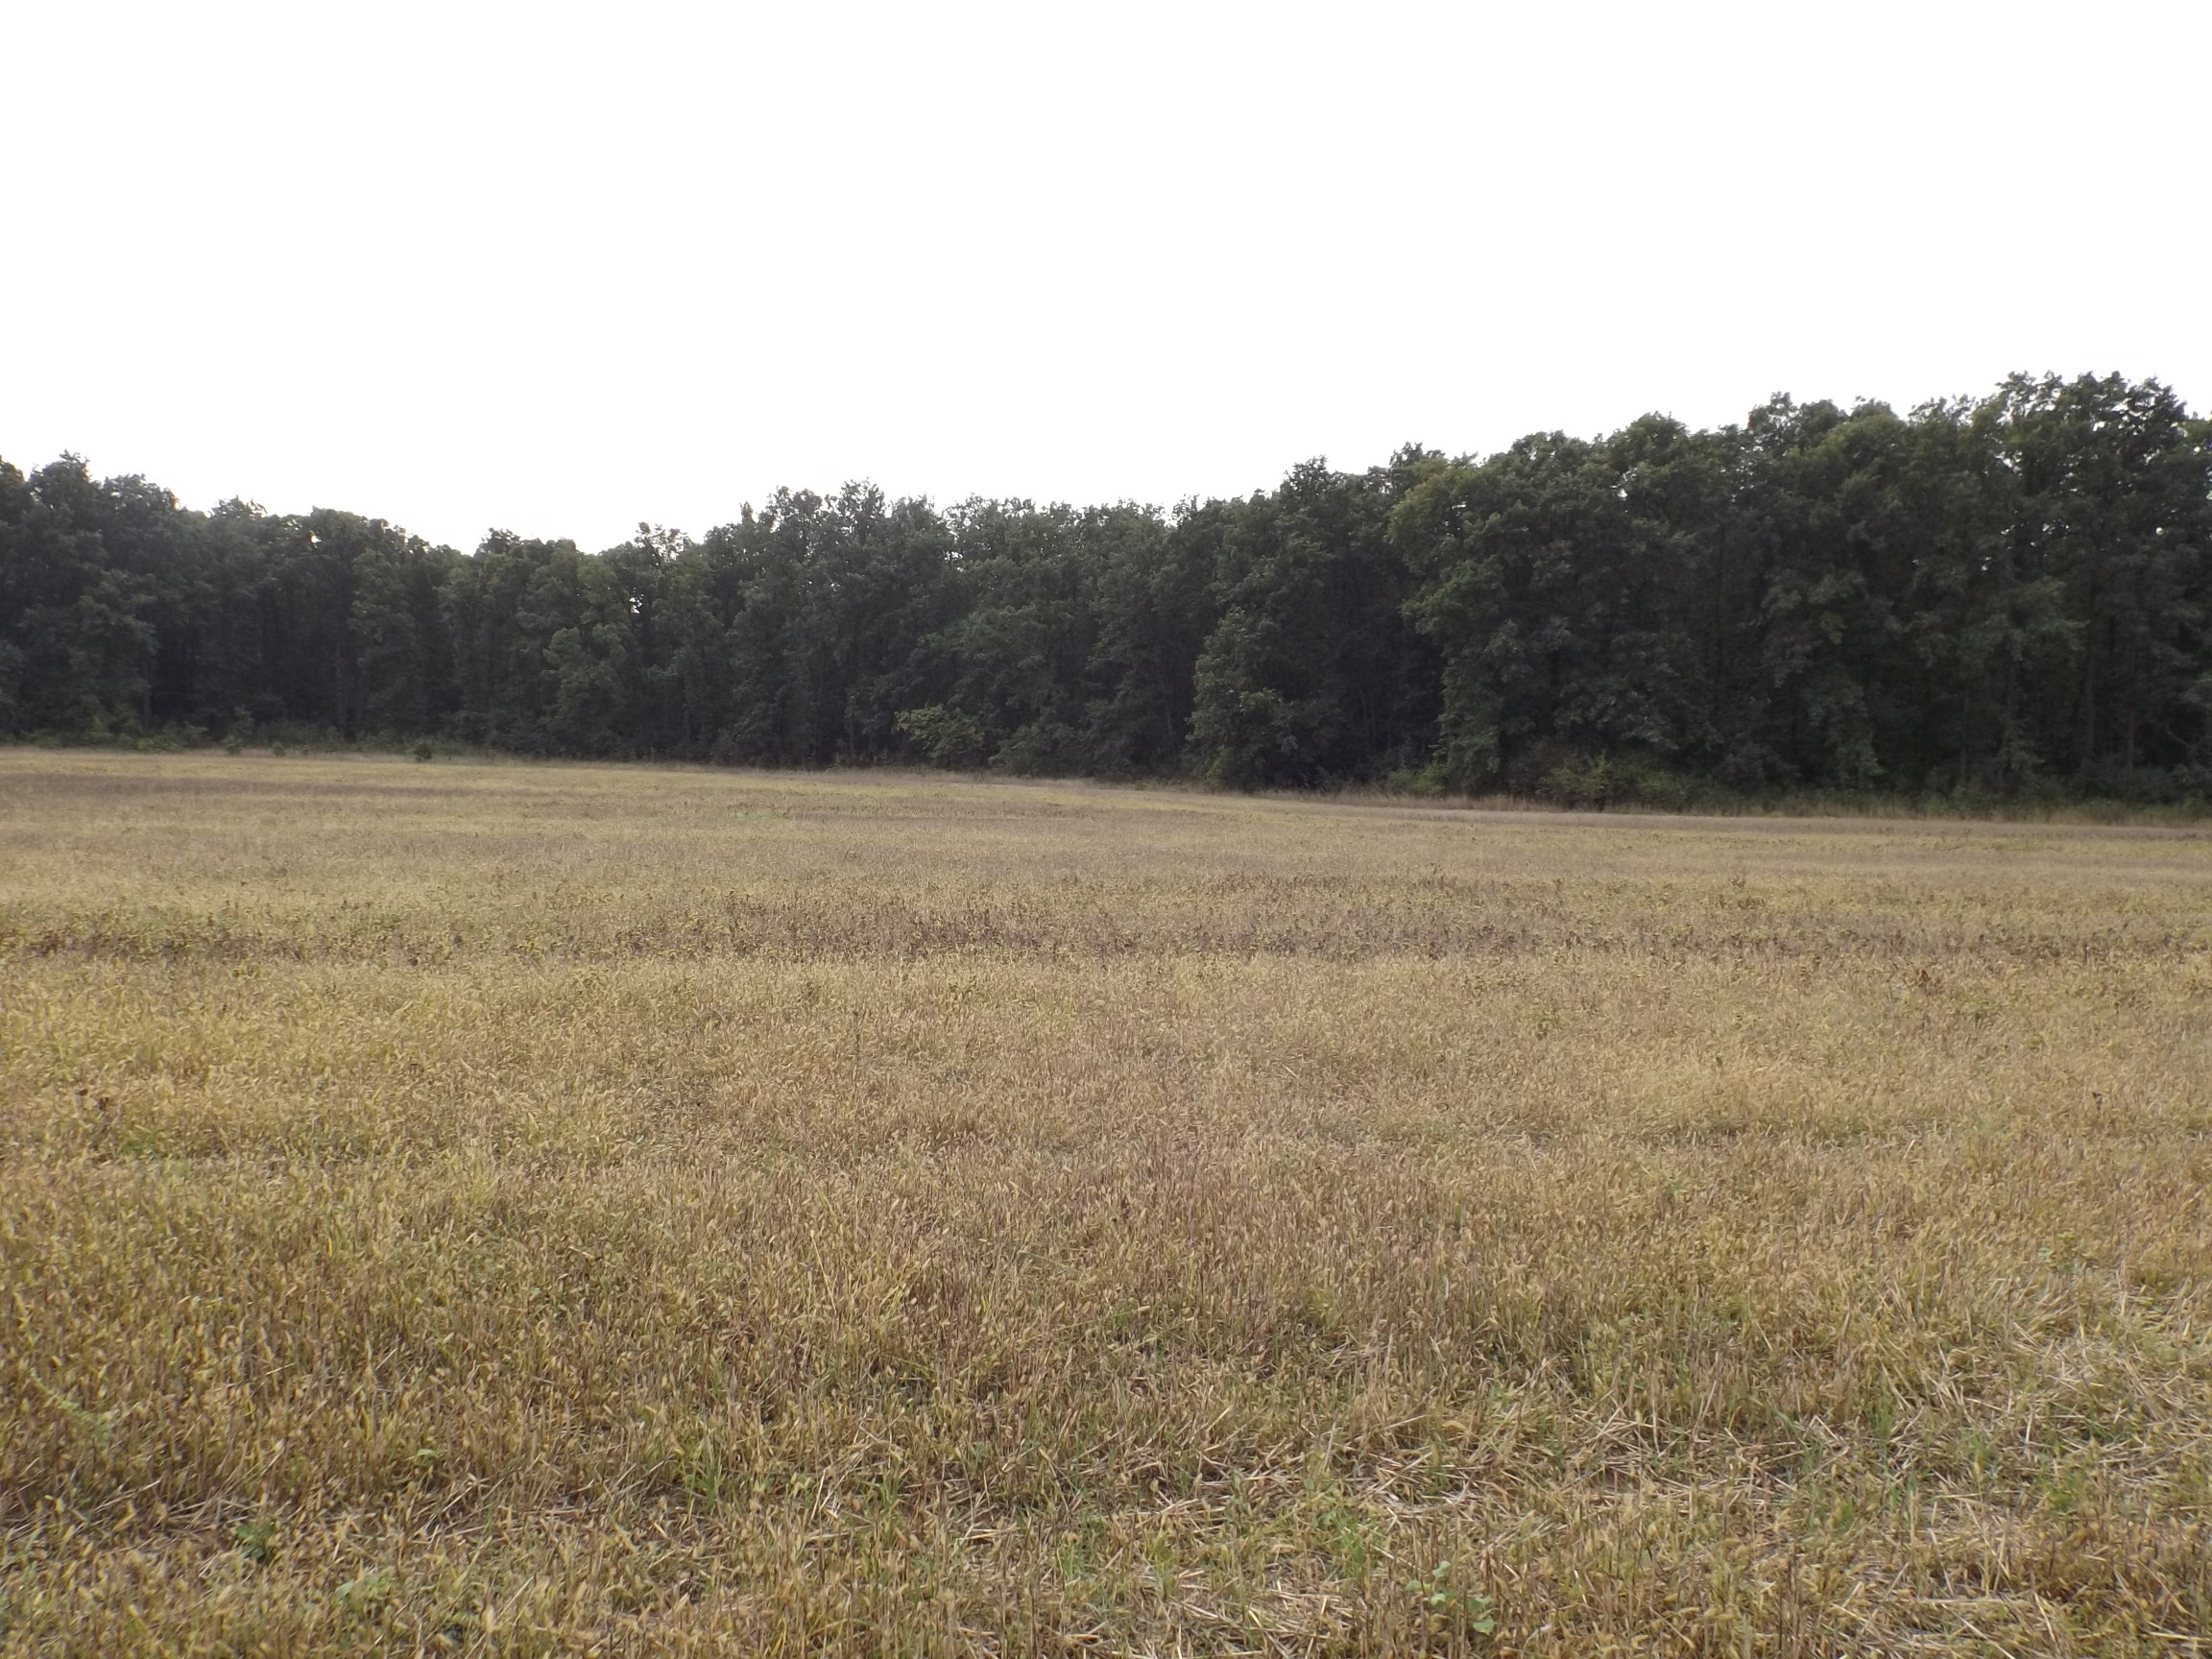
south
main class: Cropland
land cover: Common wheat
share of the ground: 10 - 25 %
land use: Agriculture (excluding fallow land and kitchen gardens)
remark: Harvested field
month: October
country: BG
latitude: 43.0206
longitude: 27.3616
